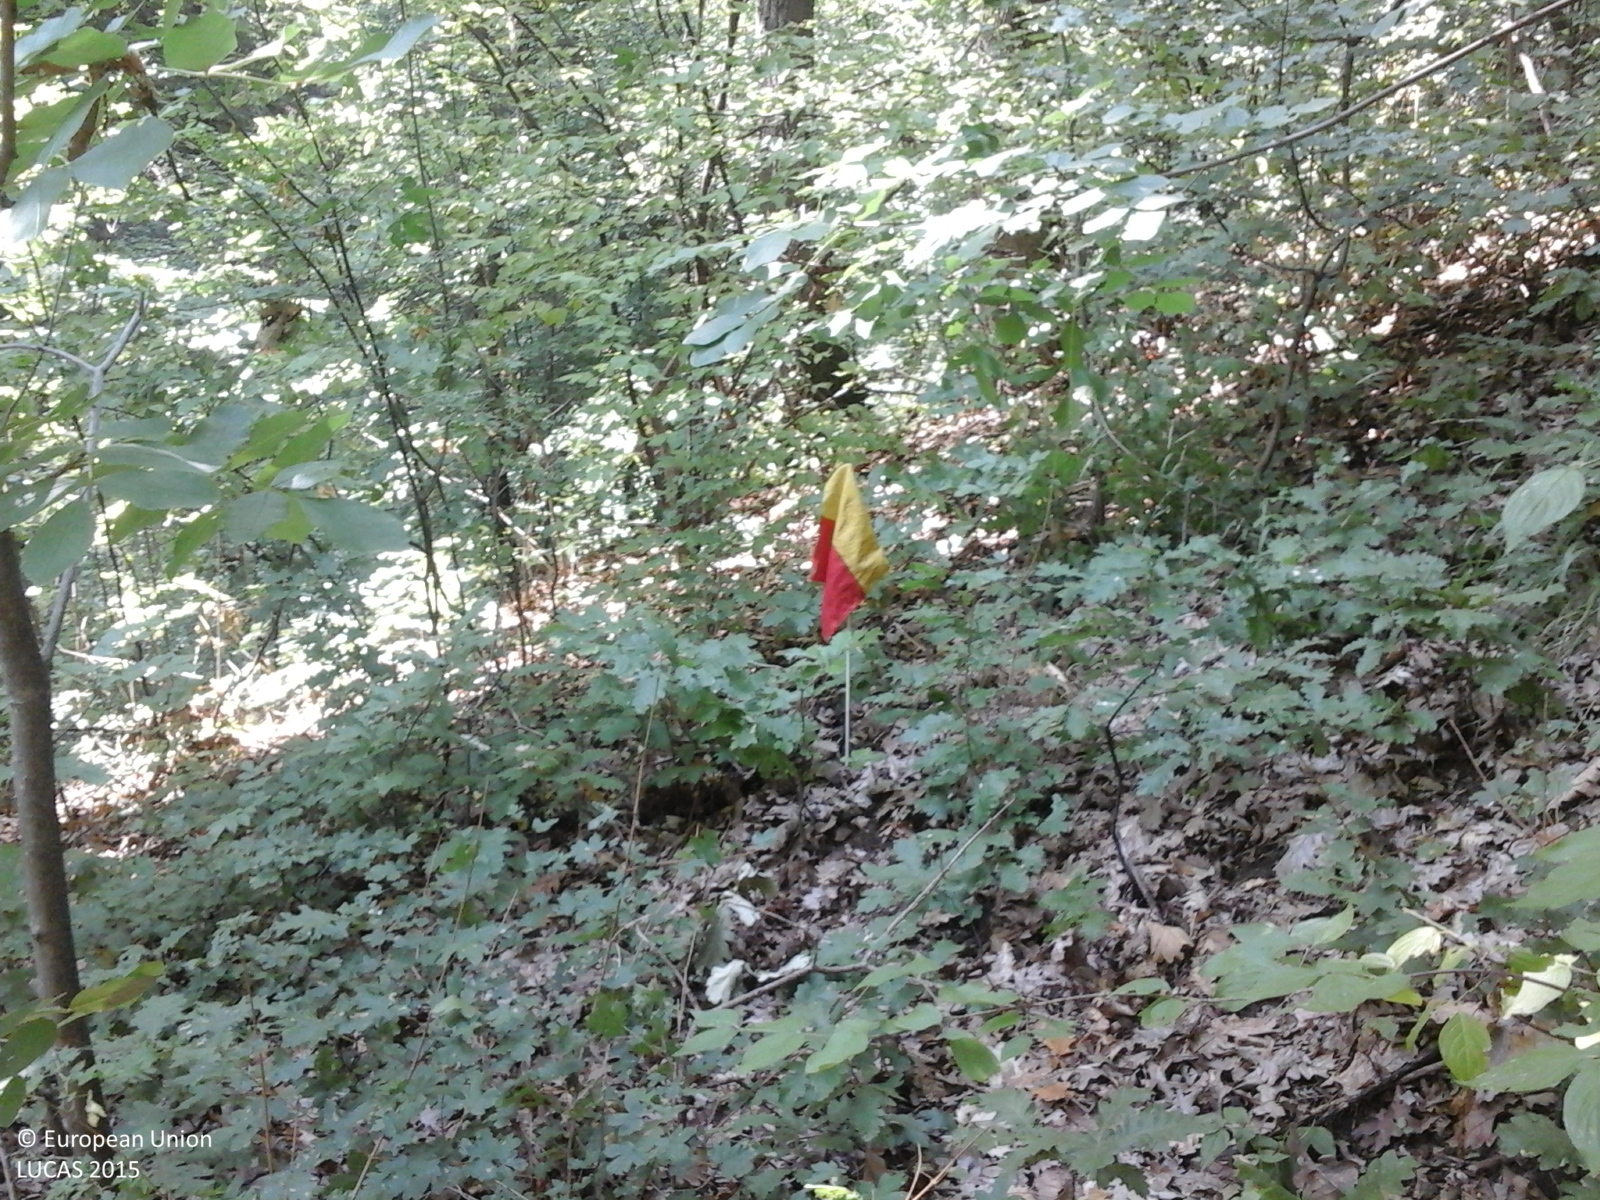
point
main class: Woodland
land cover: Broadleaved woodland
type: mesophytic deciduous forest
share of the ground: > 75 %
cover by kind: broadleaved forest trees 100 %
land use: Forestry
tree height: > 5 m
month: August
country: RO
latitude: 44.7009
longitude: 23.1108
